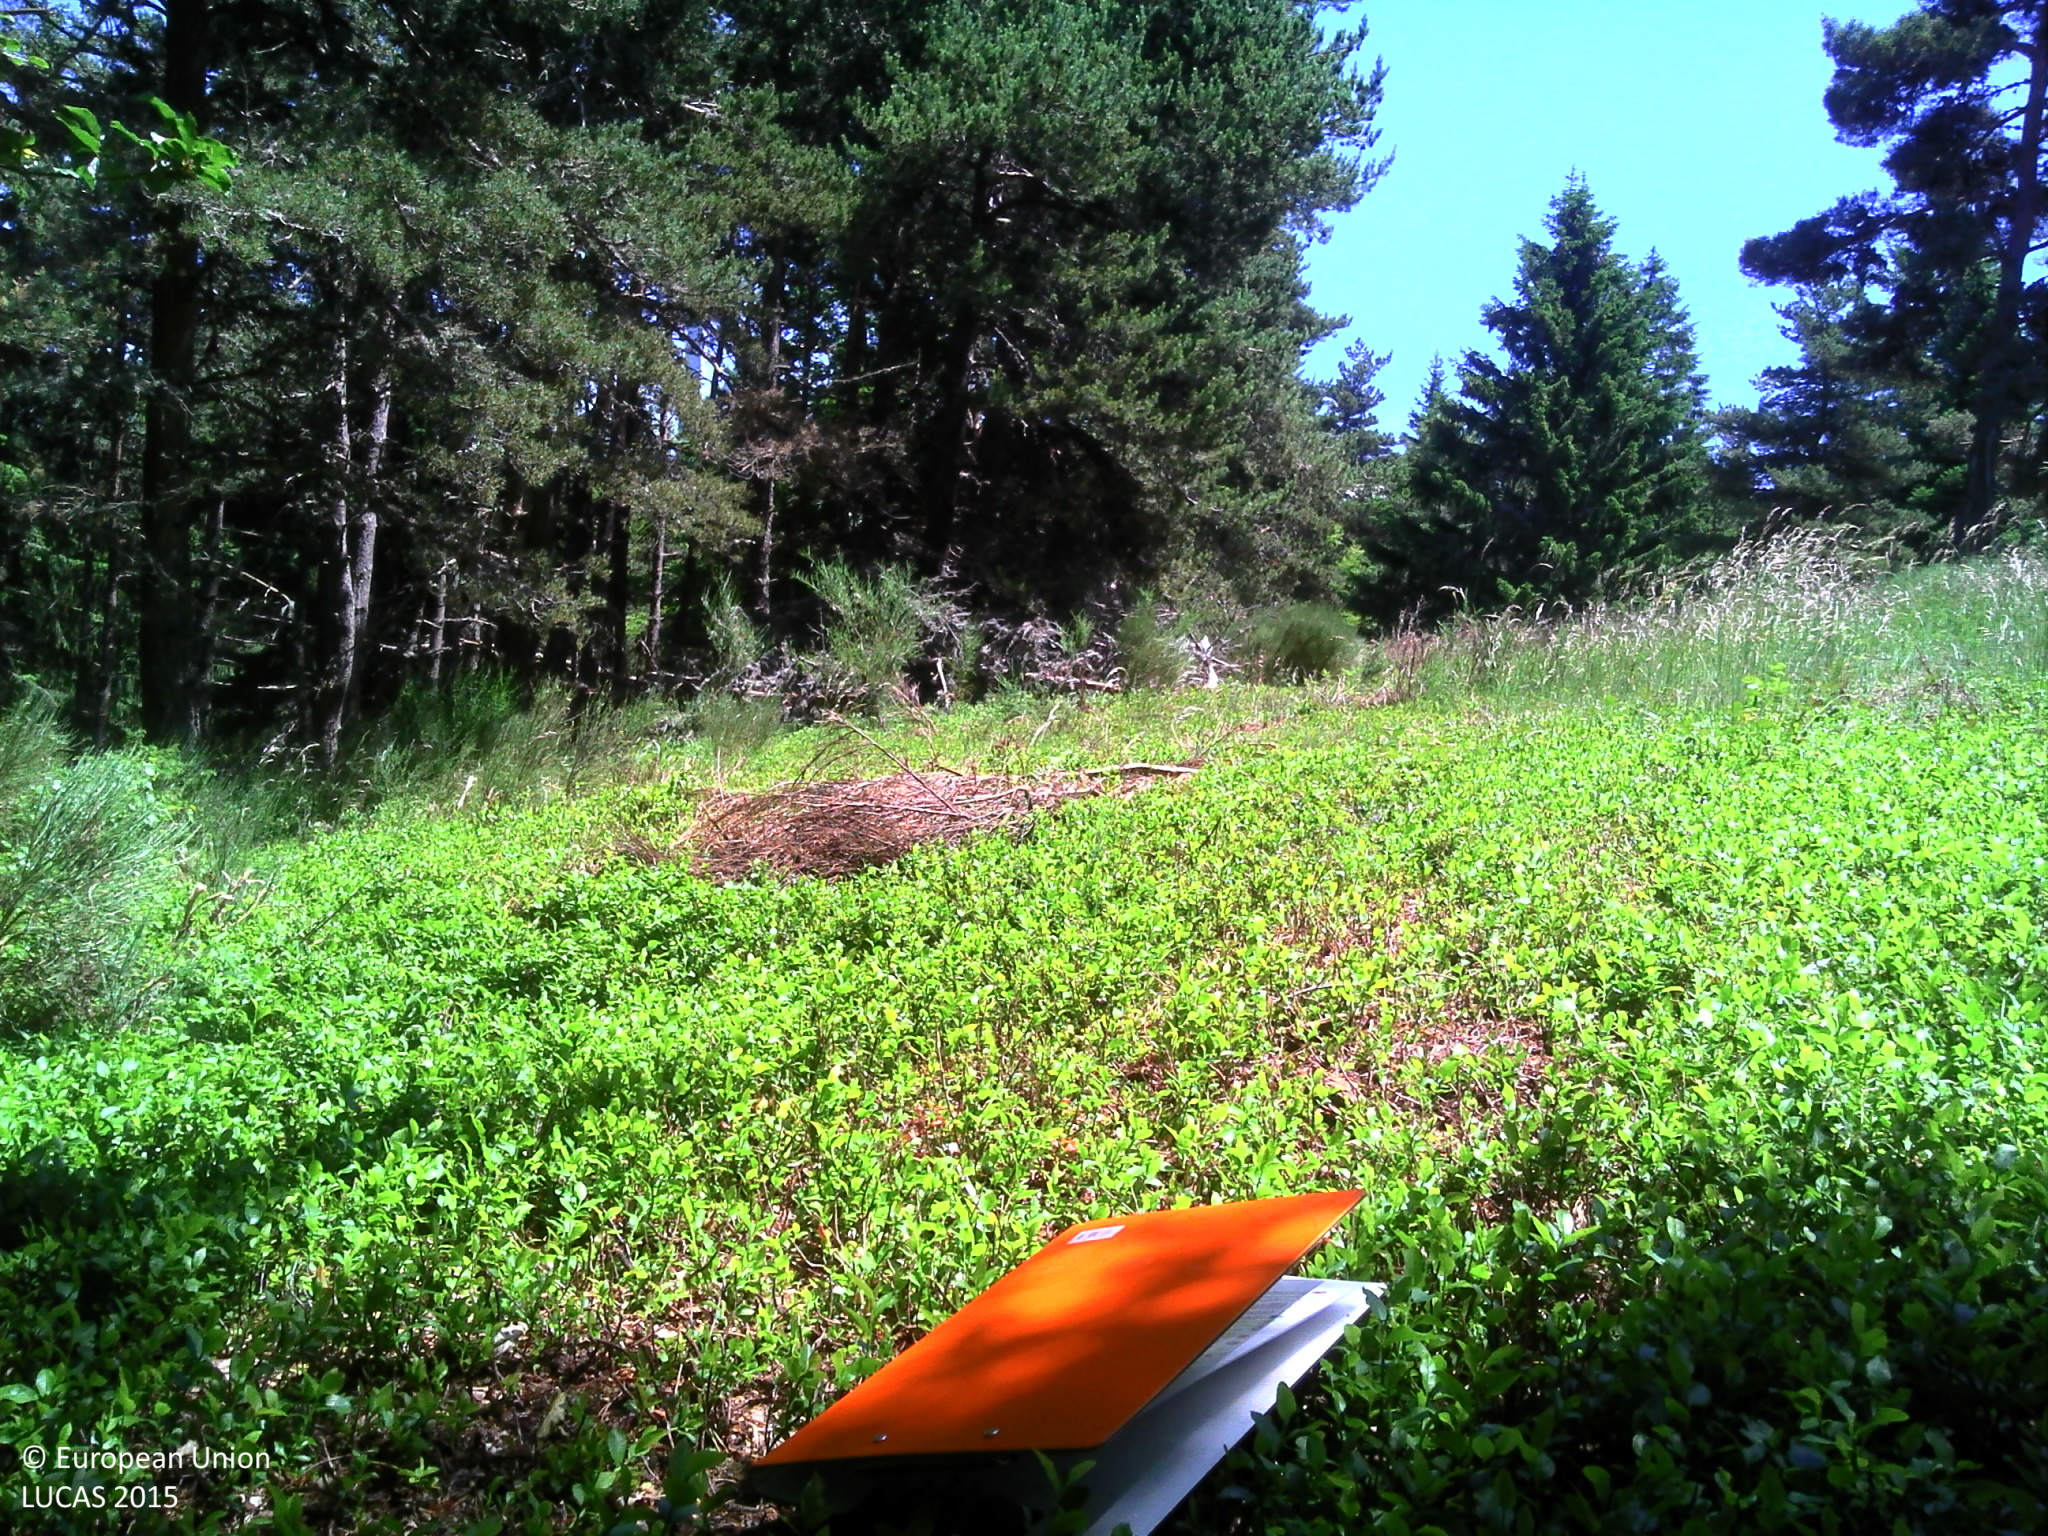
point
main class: Woodland
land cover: Pine dominated mixed woodland
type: mountainous beech forest
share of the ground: 50 - 75 %
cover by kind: herbaceous plants 40 %, broadleaved forest trees 35 %, coniferous forest trees 25 %
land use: Forestry
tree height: > 5 m
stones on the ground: 10 - 25 %
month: June
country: FR
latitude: 44.5788
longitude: 3.4686
